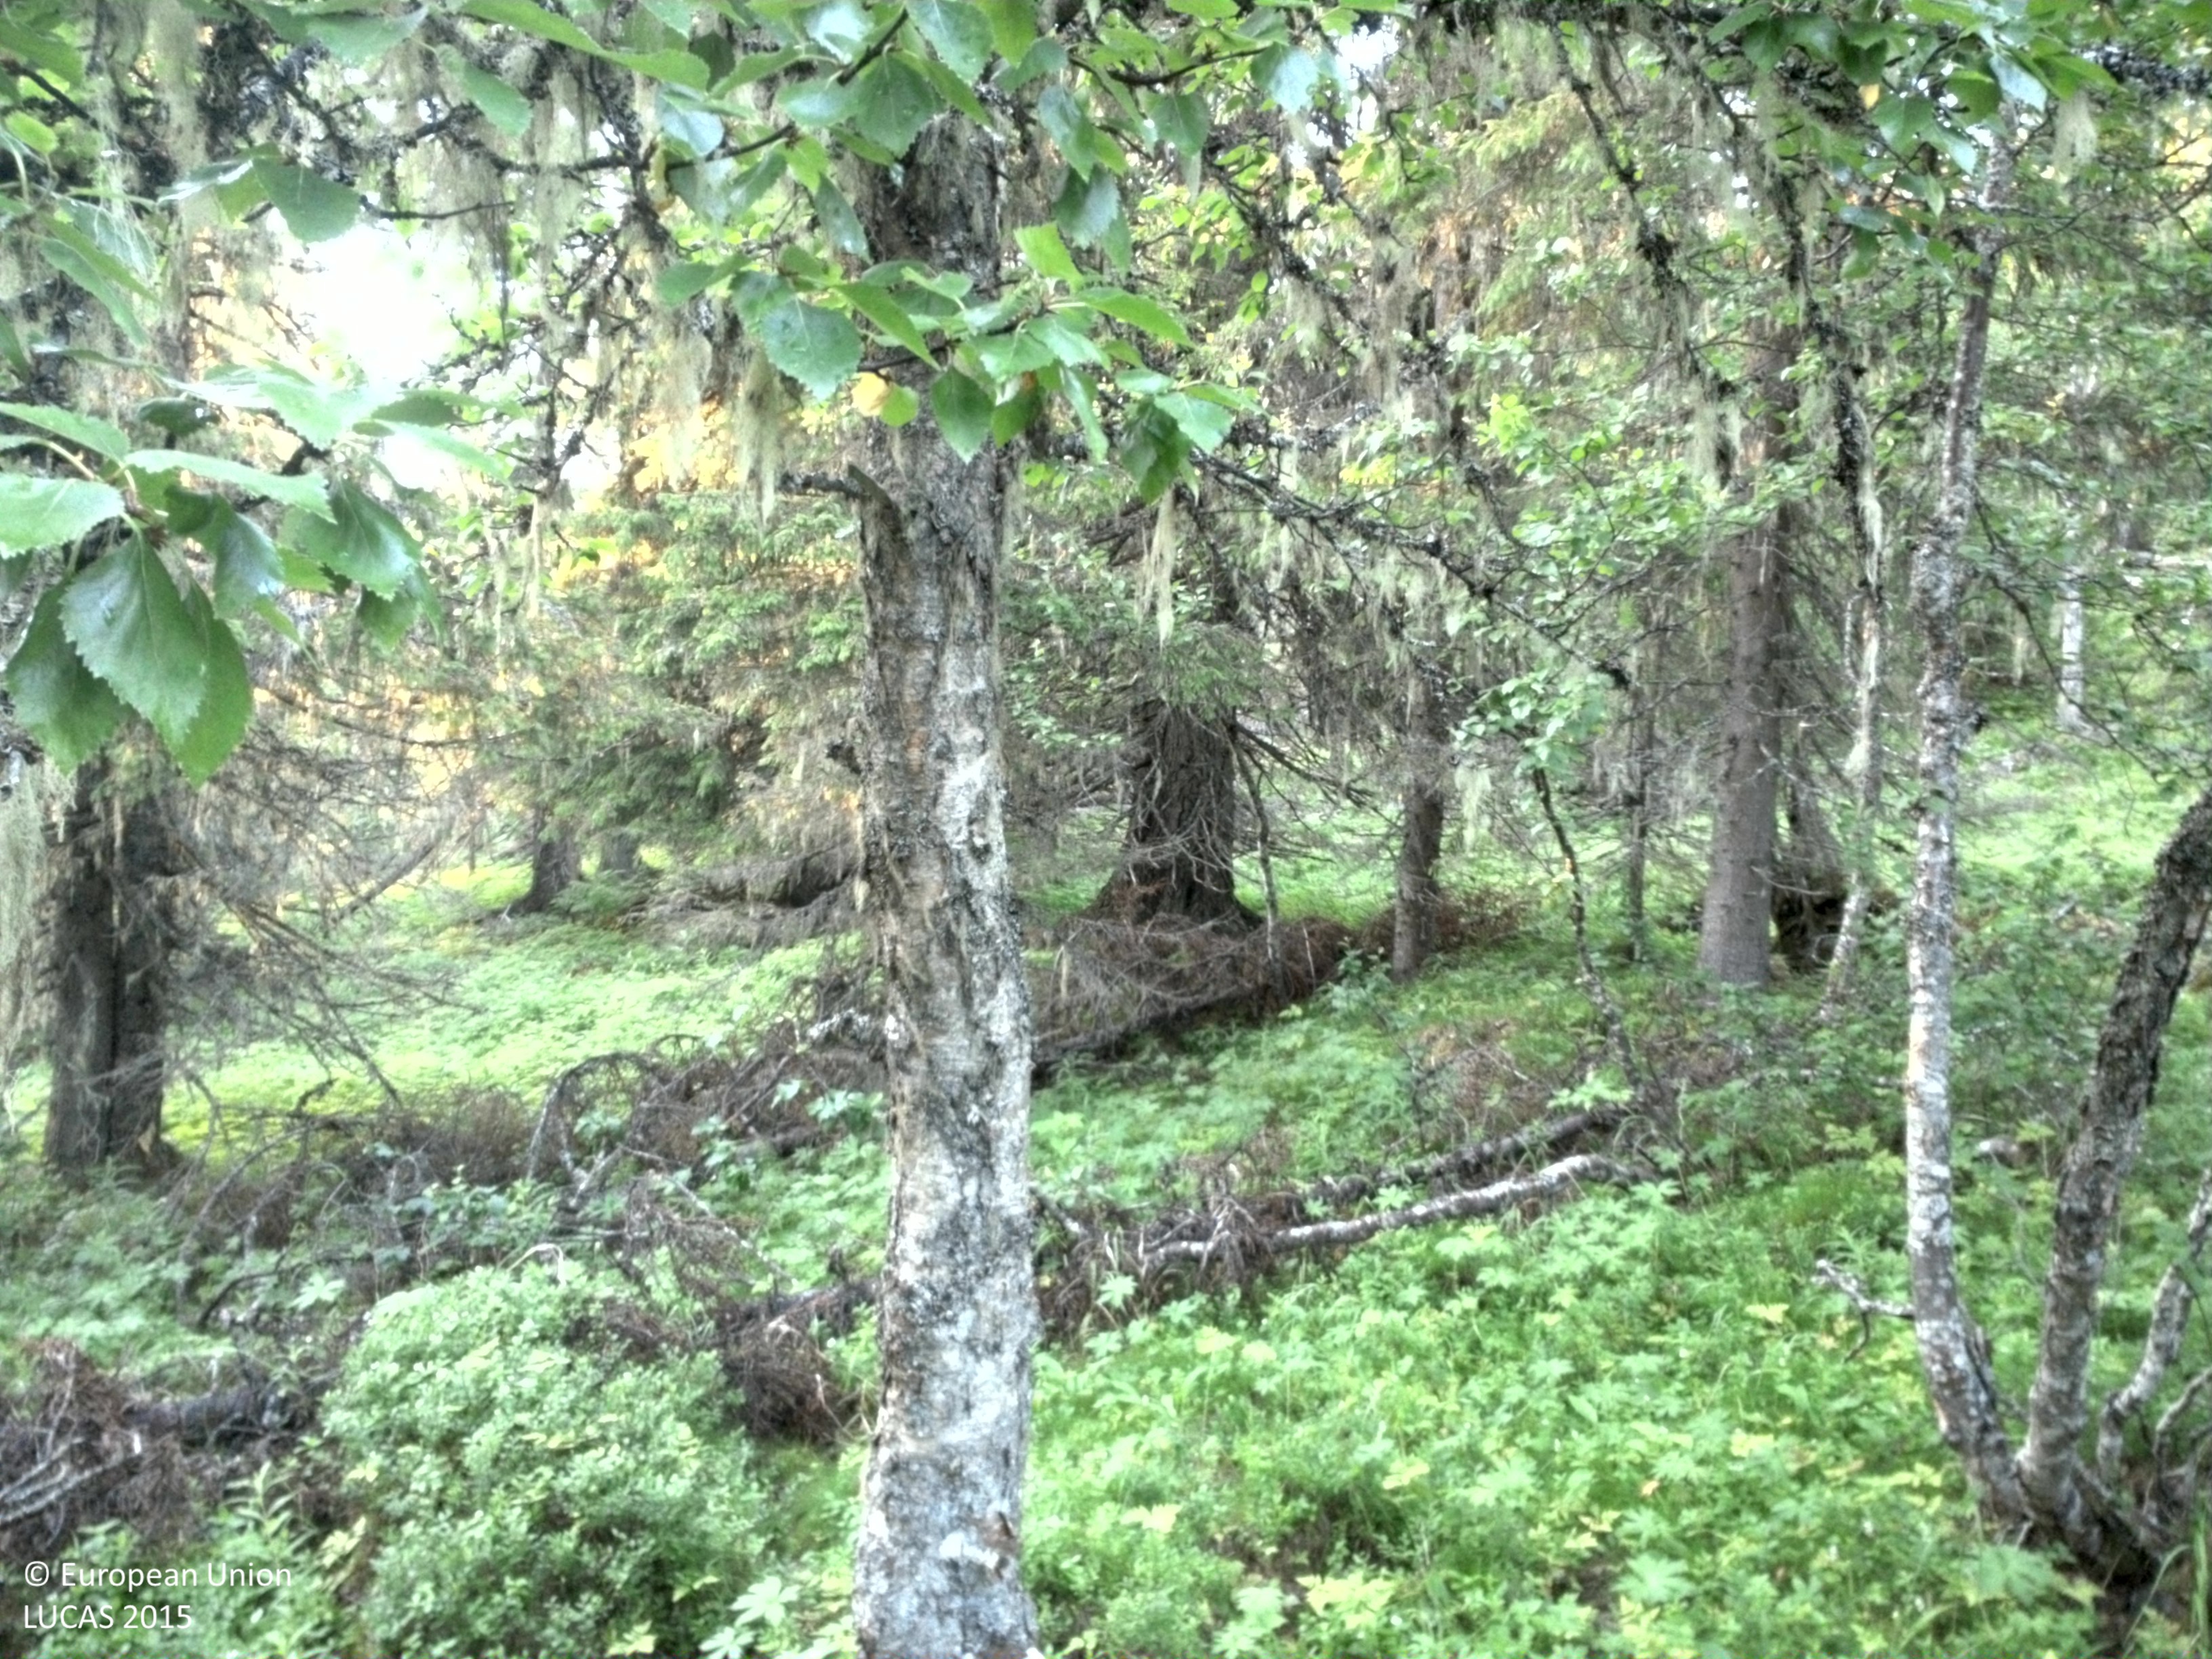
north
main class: Woodland
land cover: Spruce dominated coniferous woodland
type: boreal forest
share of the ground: 25 - 50 %
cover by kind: coniferous forest trees 40 %, herbaceous plants 30 %, shrubs 25 %, lichens and mosses 5 %
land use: Forestry
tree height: > 5 m
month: August
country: SE
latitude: 64.9746
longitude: 15.9619
